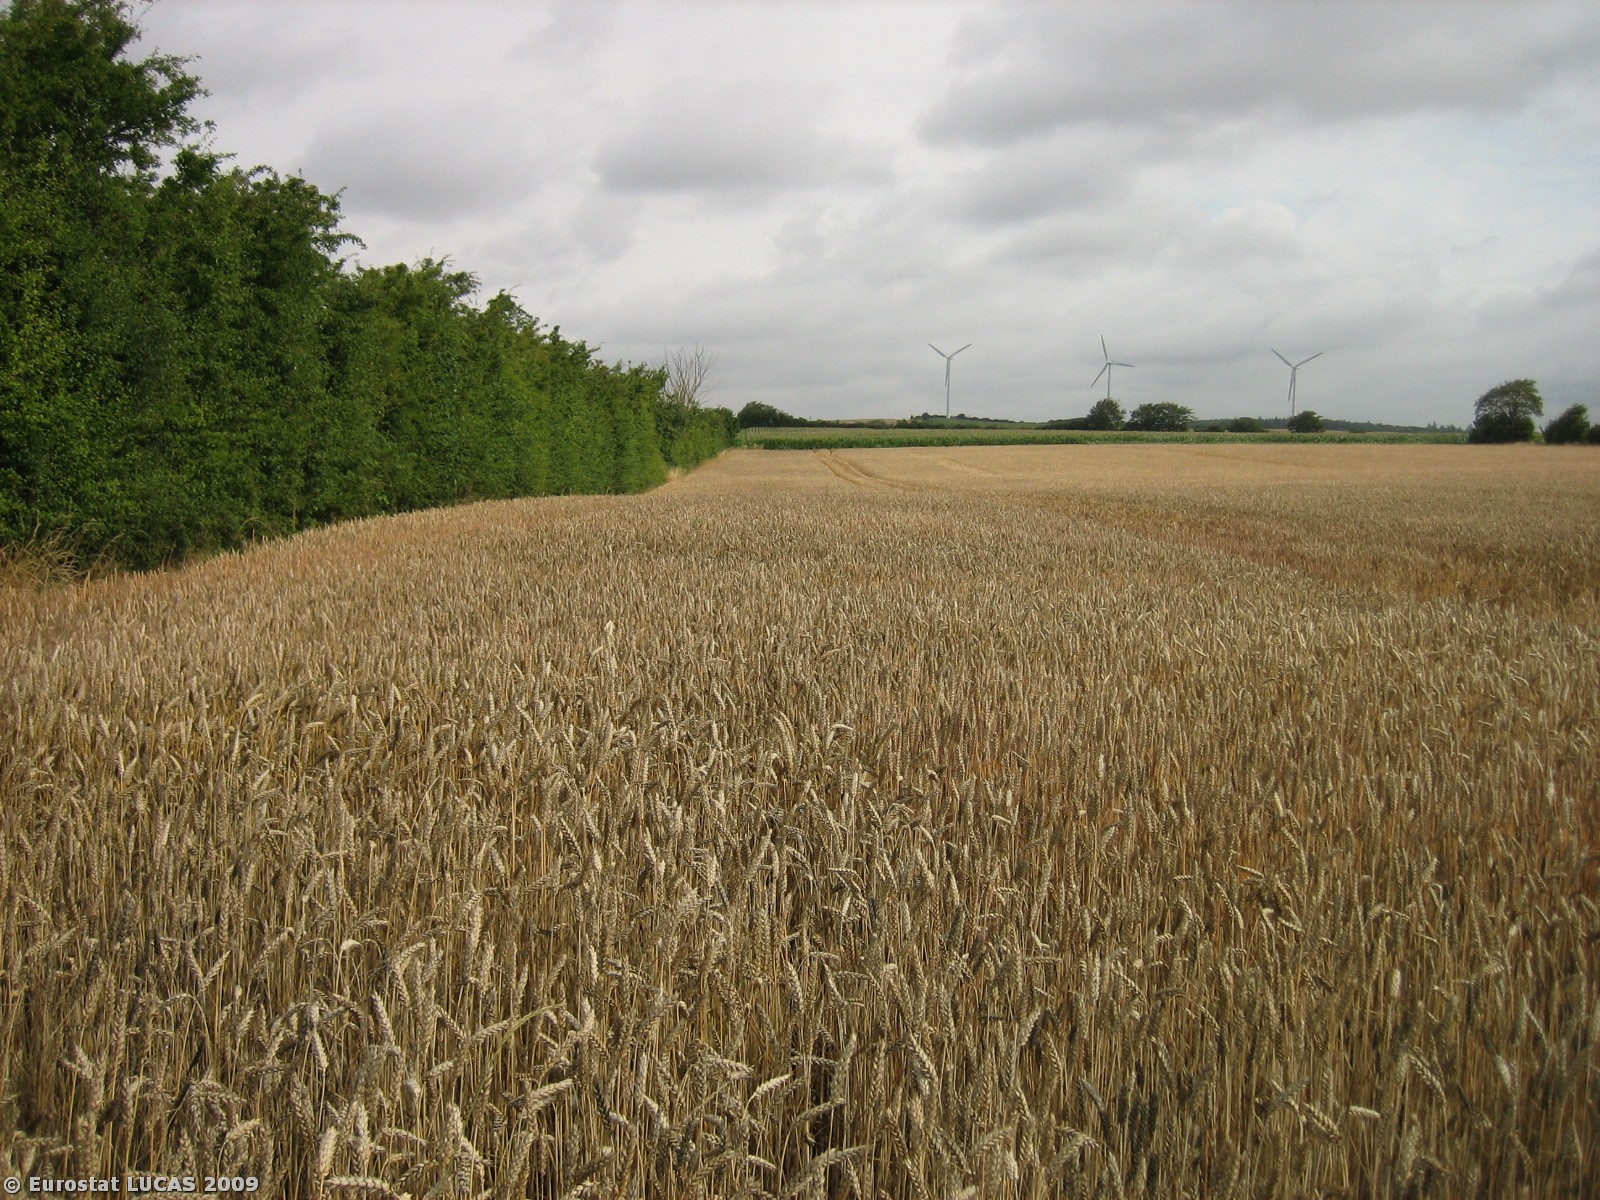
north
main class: Cropland
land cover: Common wheat
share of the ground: > 75 %
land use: Agriculture (excluding fallow land and kitchen gardens)
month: July
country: DK
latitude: 55.2171
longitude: 10.0471
